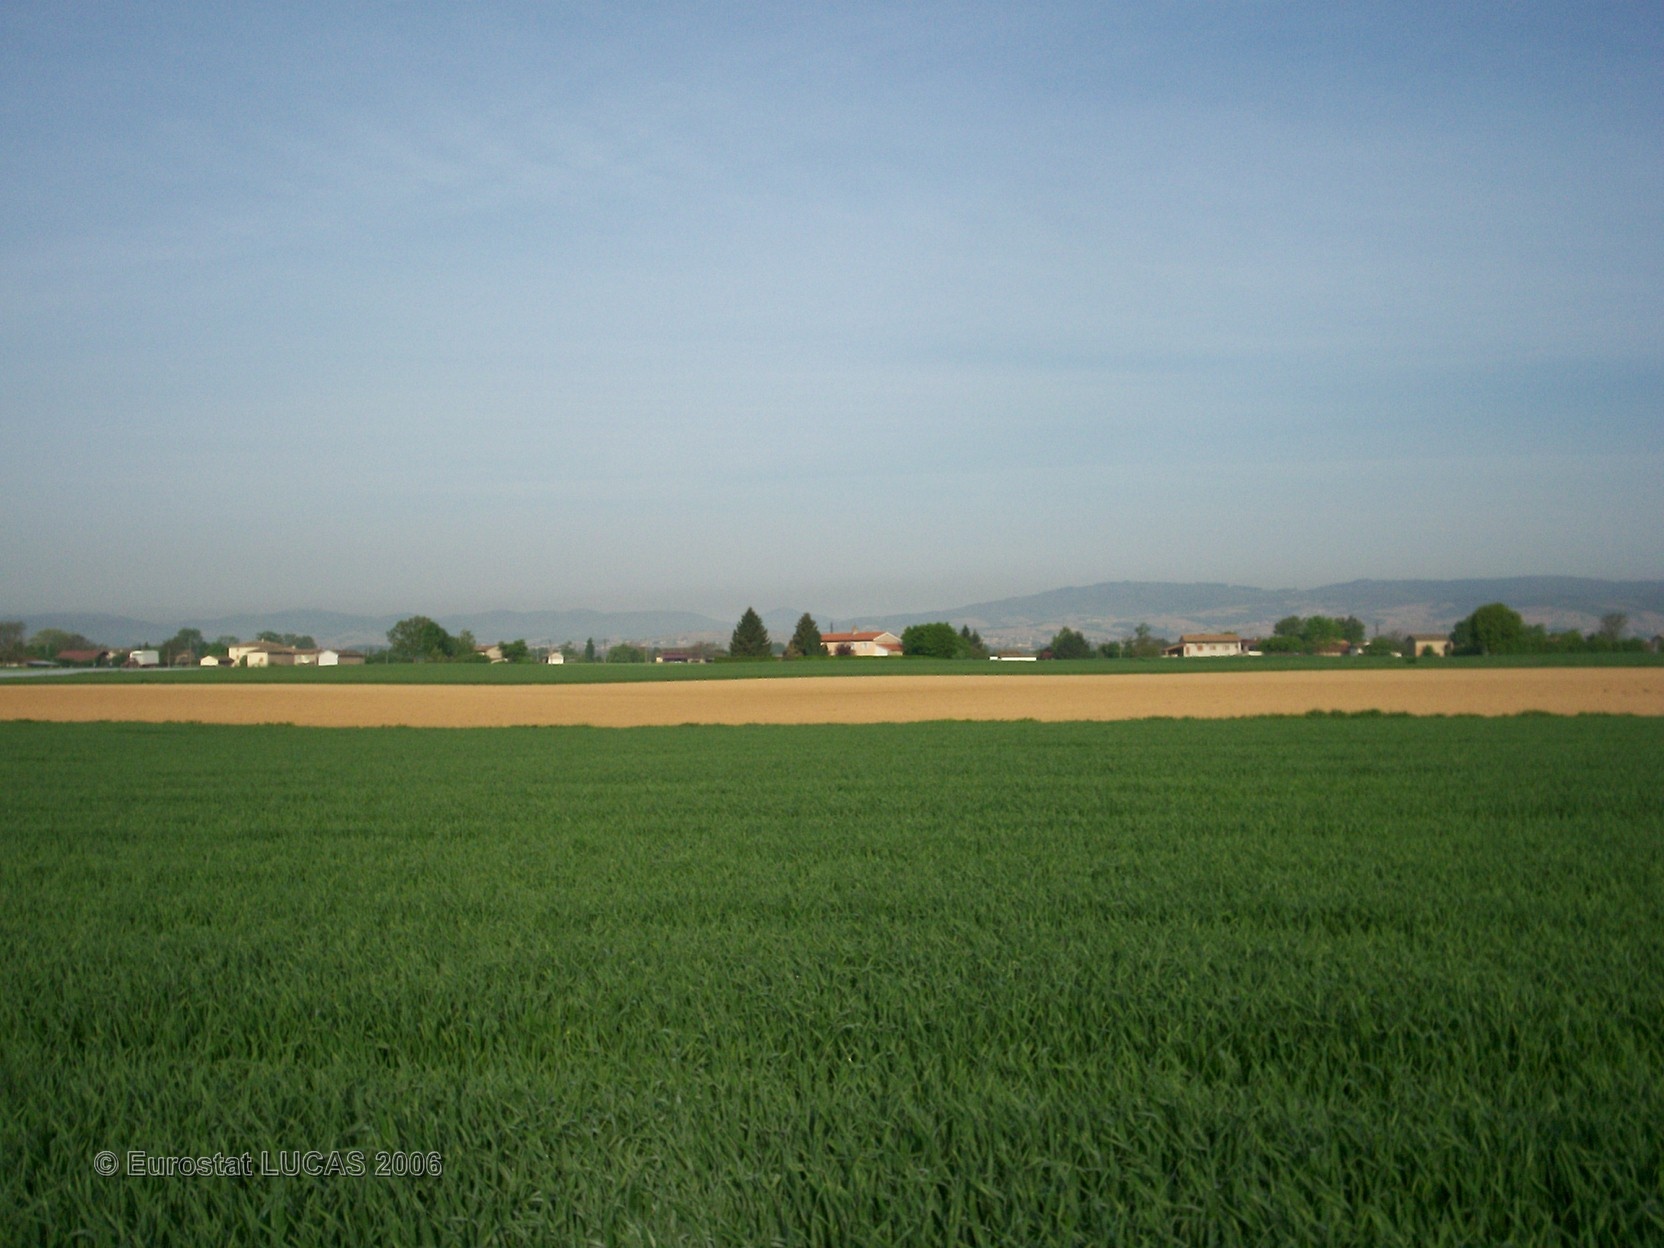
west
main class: Cropland
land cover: Common wheat
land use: Agriculture (excluding fallow land and kitchen gardens)
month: May
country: FR
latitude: 46.1518
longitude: 4.7846
